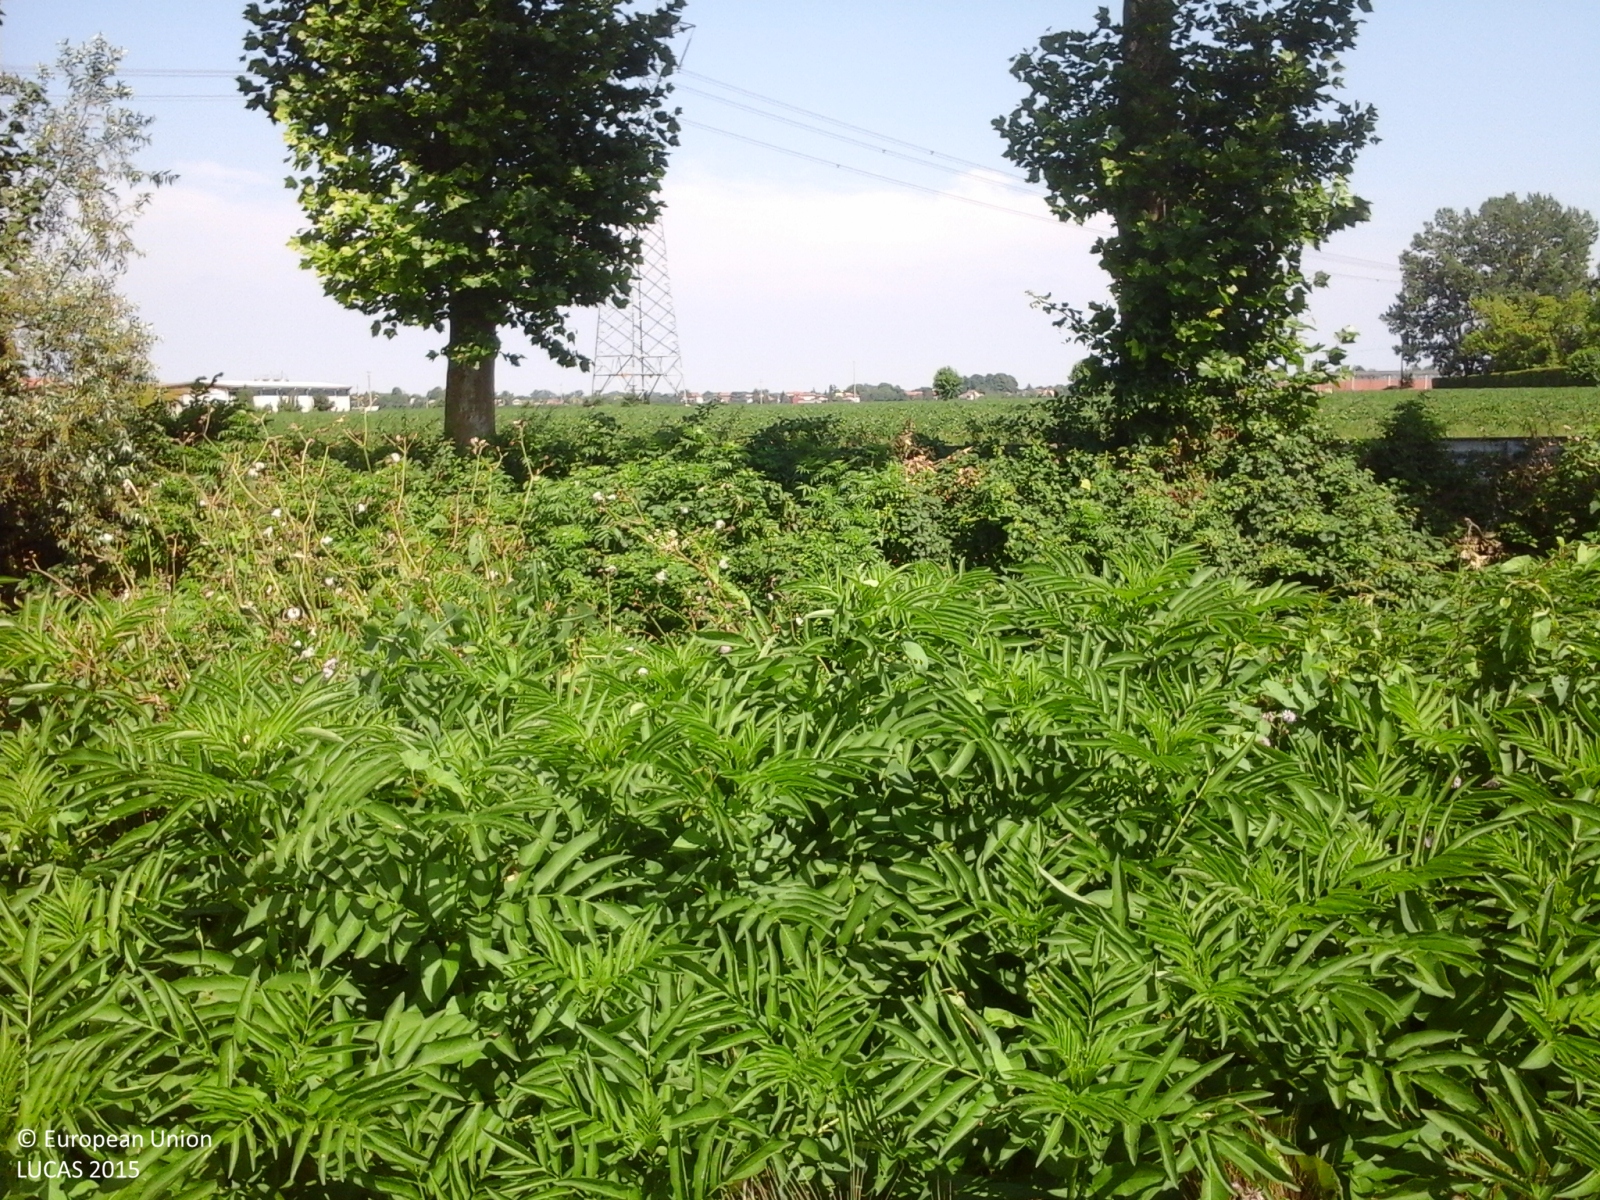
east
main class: Cropland
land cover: Barley
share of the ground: > 75 %
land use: Agriculture (excluding fallow land and kitchen gardens)
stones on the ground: < 10 %
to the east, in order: Barley; Shrubland without tree cover; Ditches and canals; Lines of trees; Paved roads, cycling and walking lanes; Grass margins; Tomatoes; Electric lines; Tomatoes
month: June
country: IT
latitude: 44.7468
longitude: 10.3151
